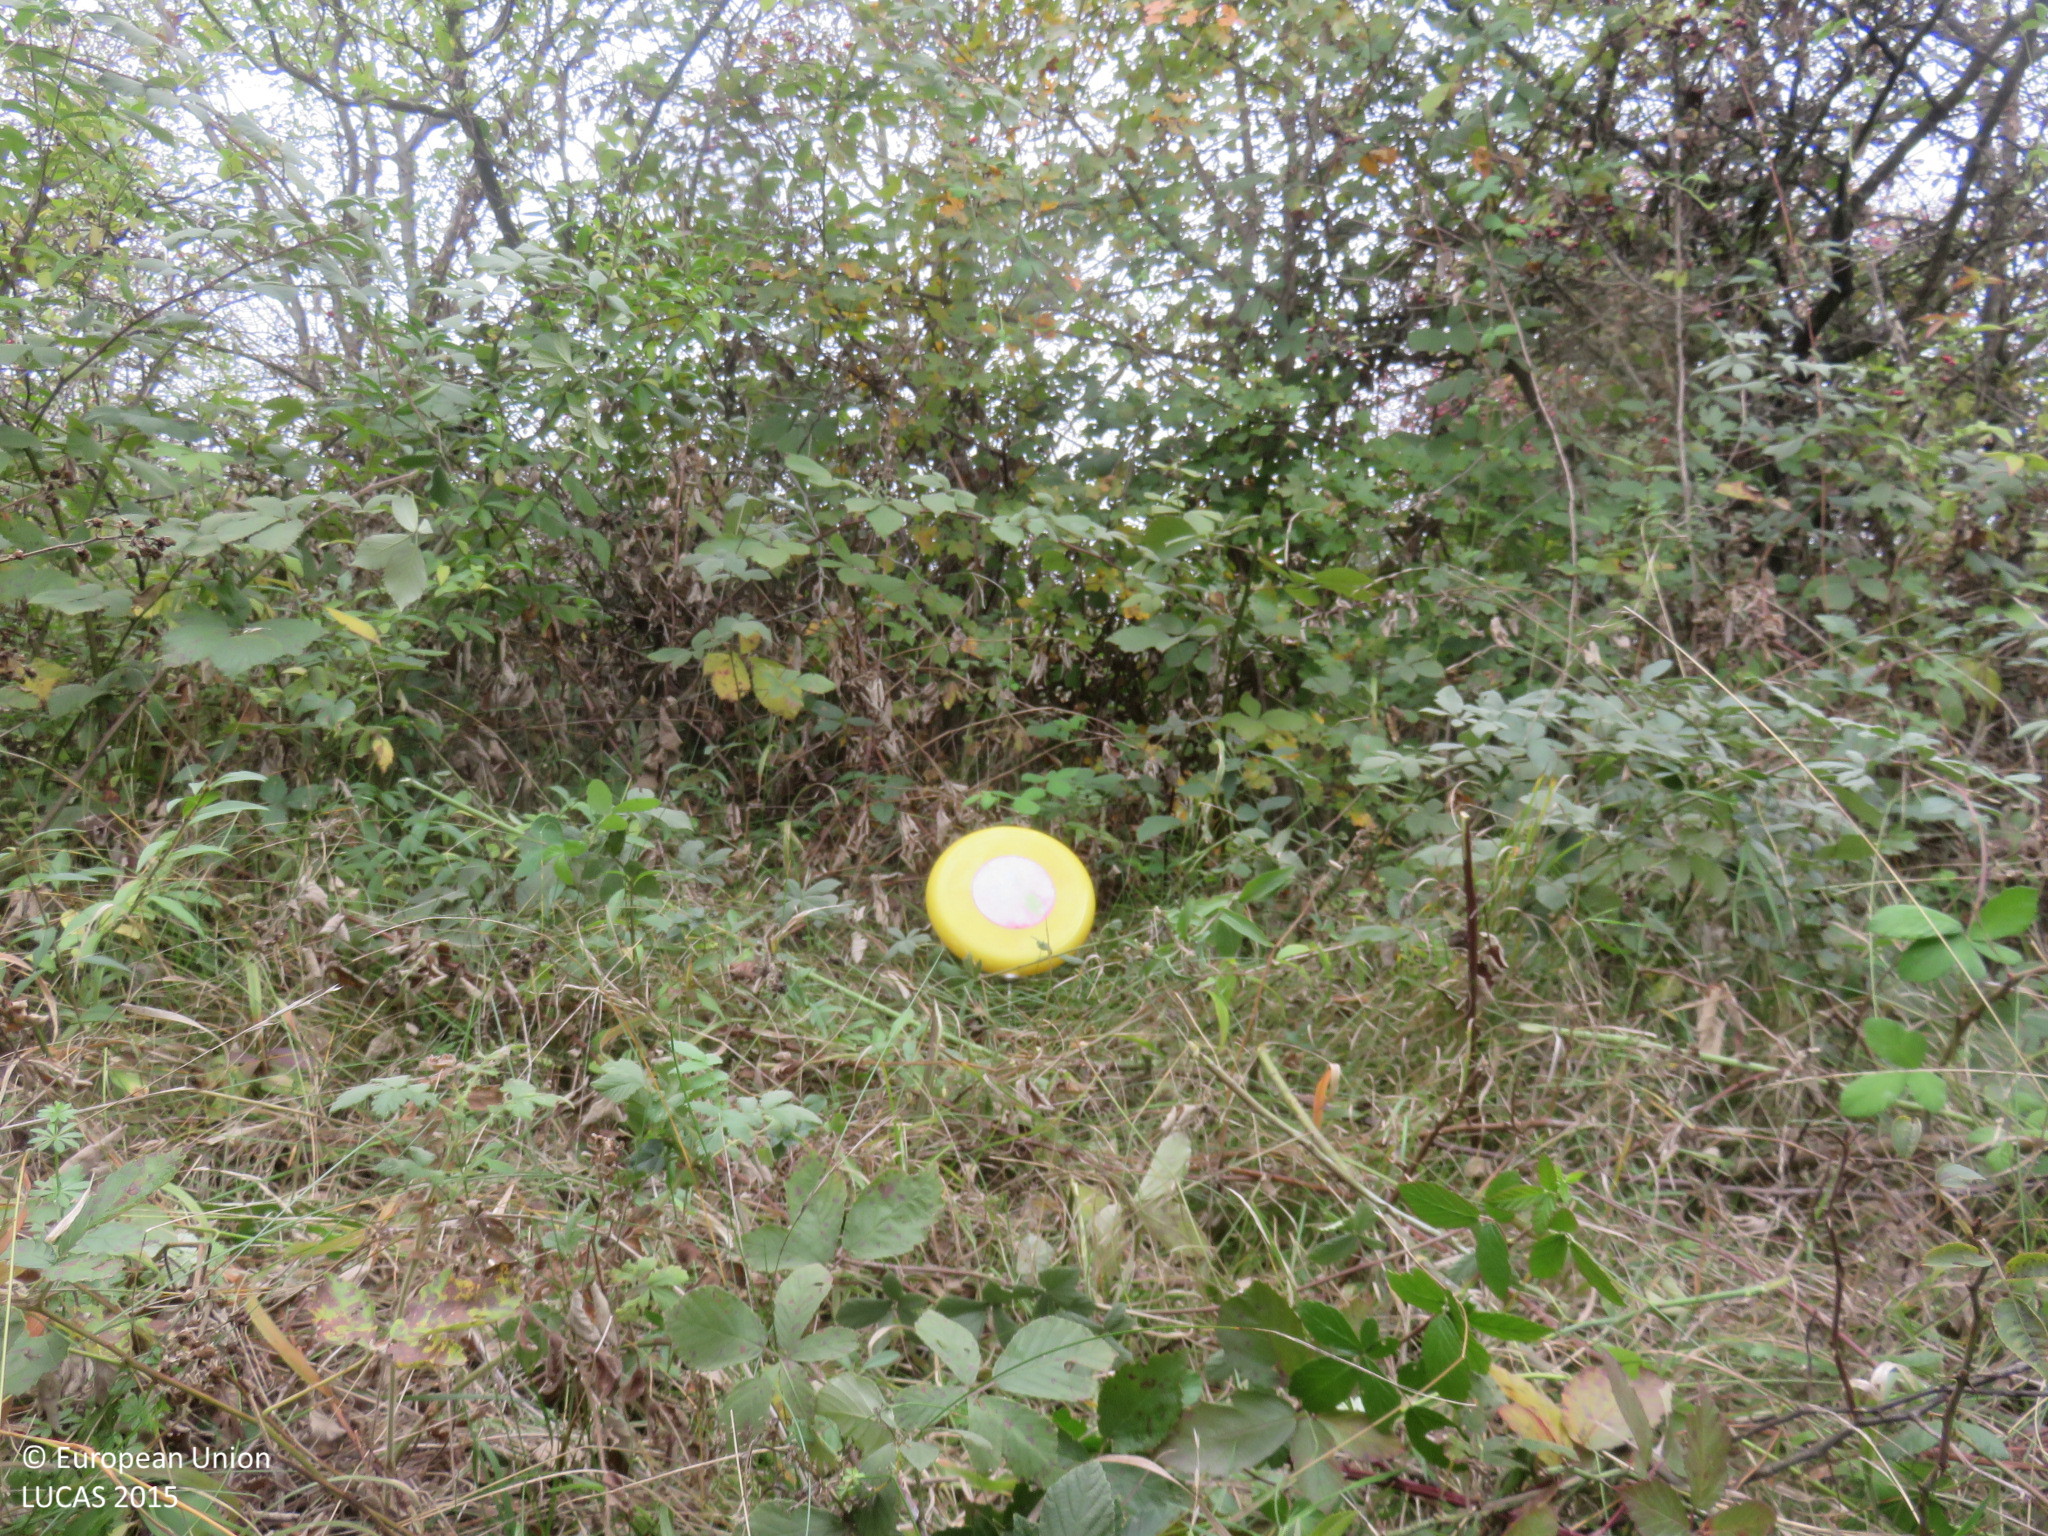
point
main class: Shrubland
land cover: Shrubland with sparse tree cover
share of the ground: > 75 %
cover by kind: shrubs 90 %, broadleaved forest trees 5 %, herbaceous plants 5 %
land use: Semi-natural and natural areas not in use
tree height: < 5 m
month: October
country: BG
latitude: 42.9331
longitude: 25.1771
